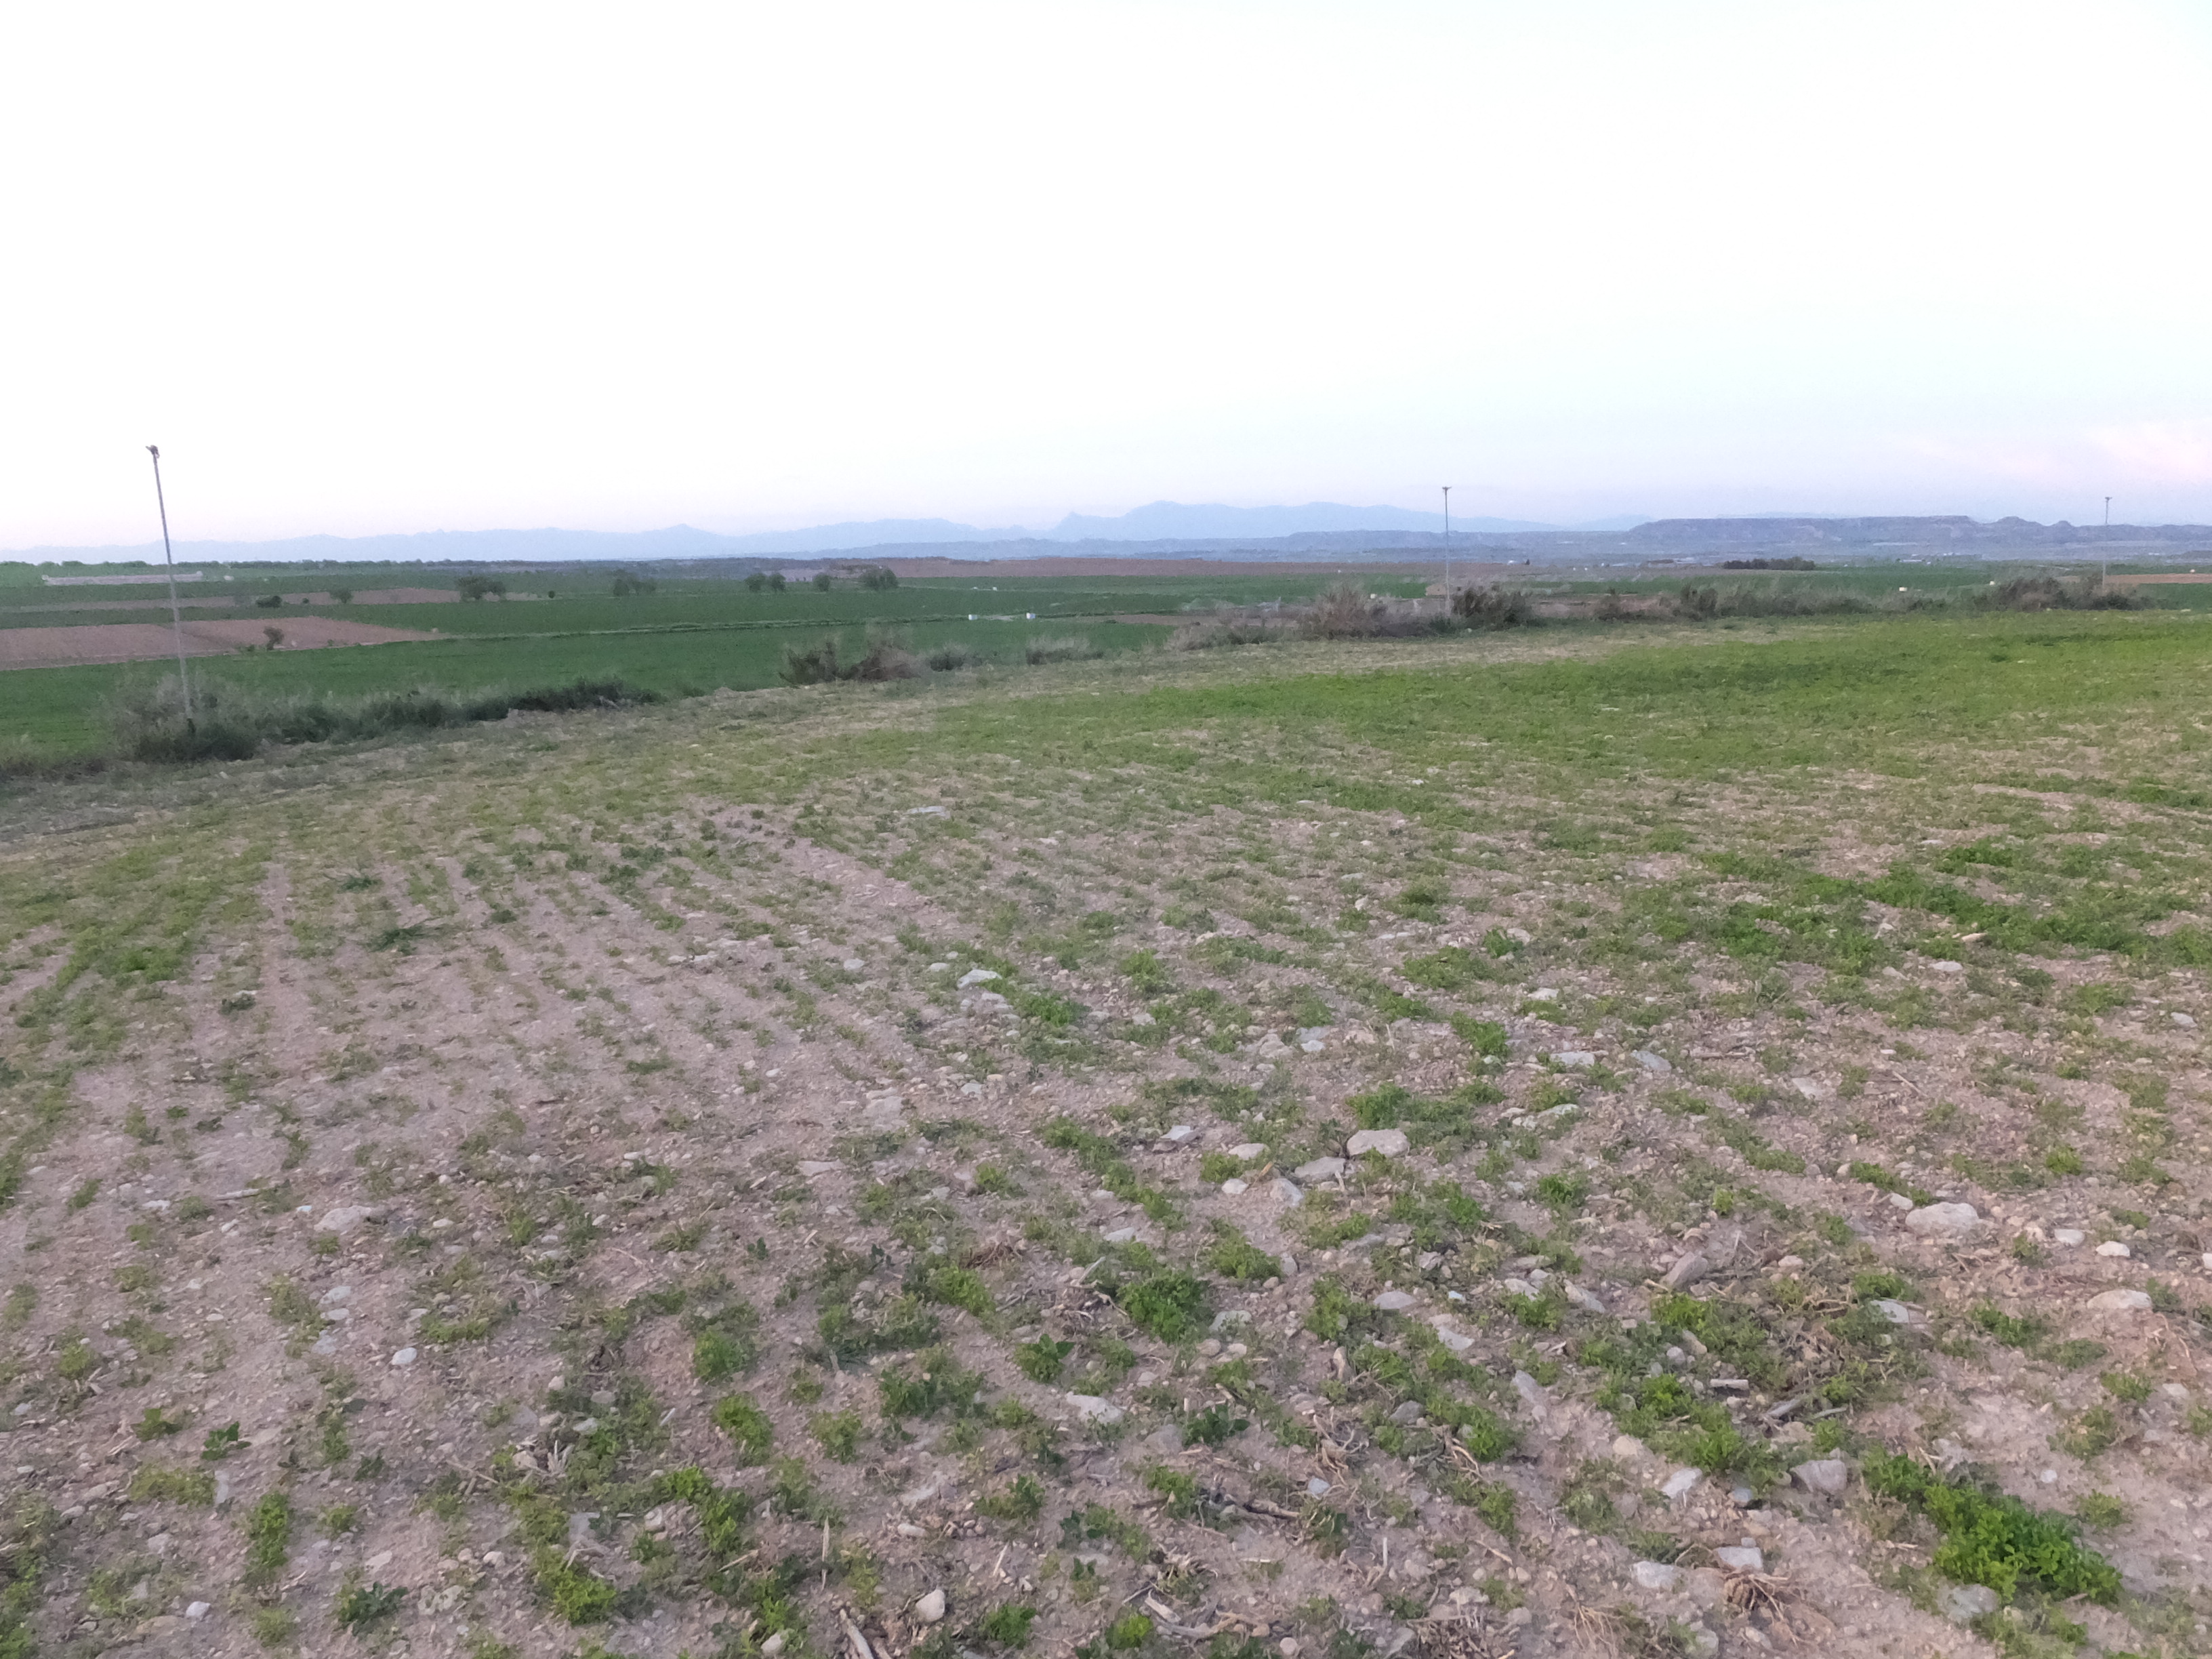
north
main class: Cropland
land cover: Lucerne
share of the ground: > 75 %
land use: Agriculture (excluding fallow land and kitchen gardens)
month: April
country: ES
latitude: 41.8324
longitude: -0.3388
